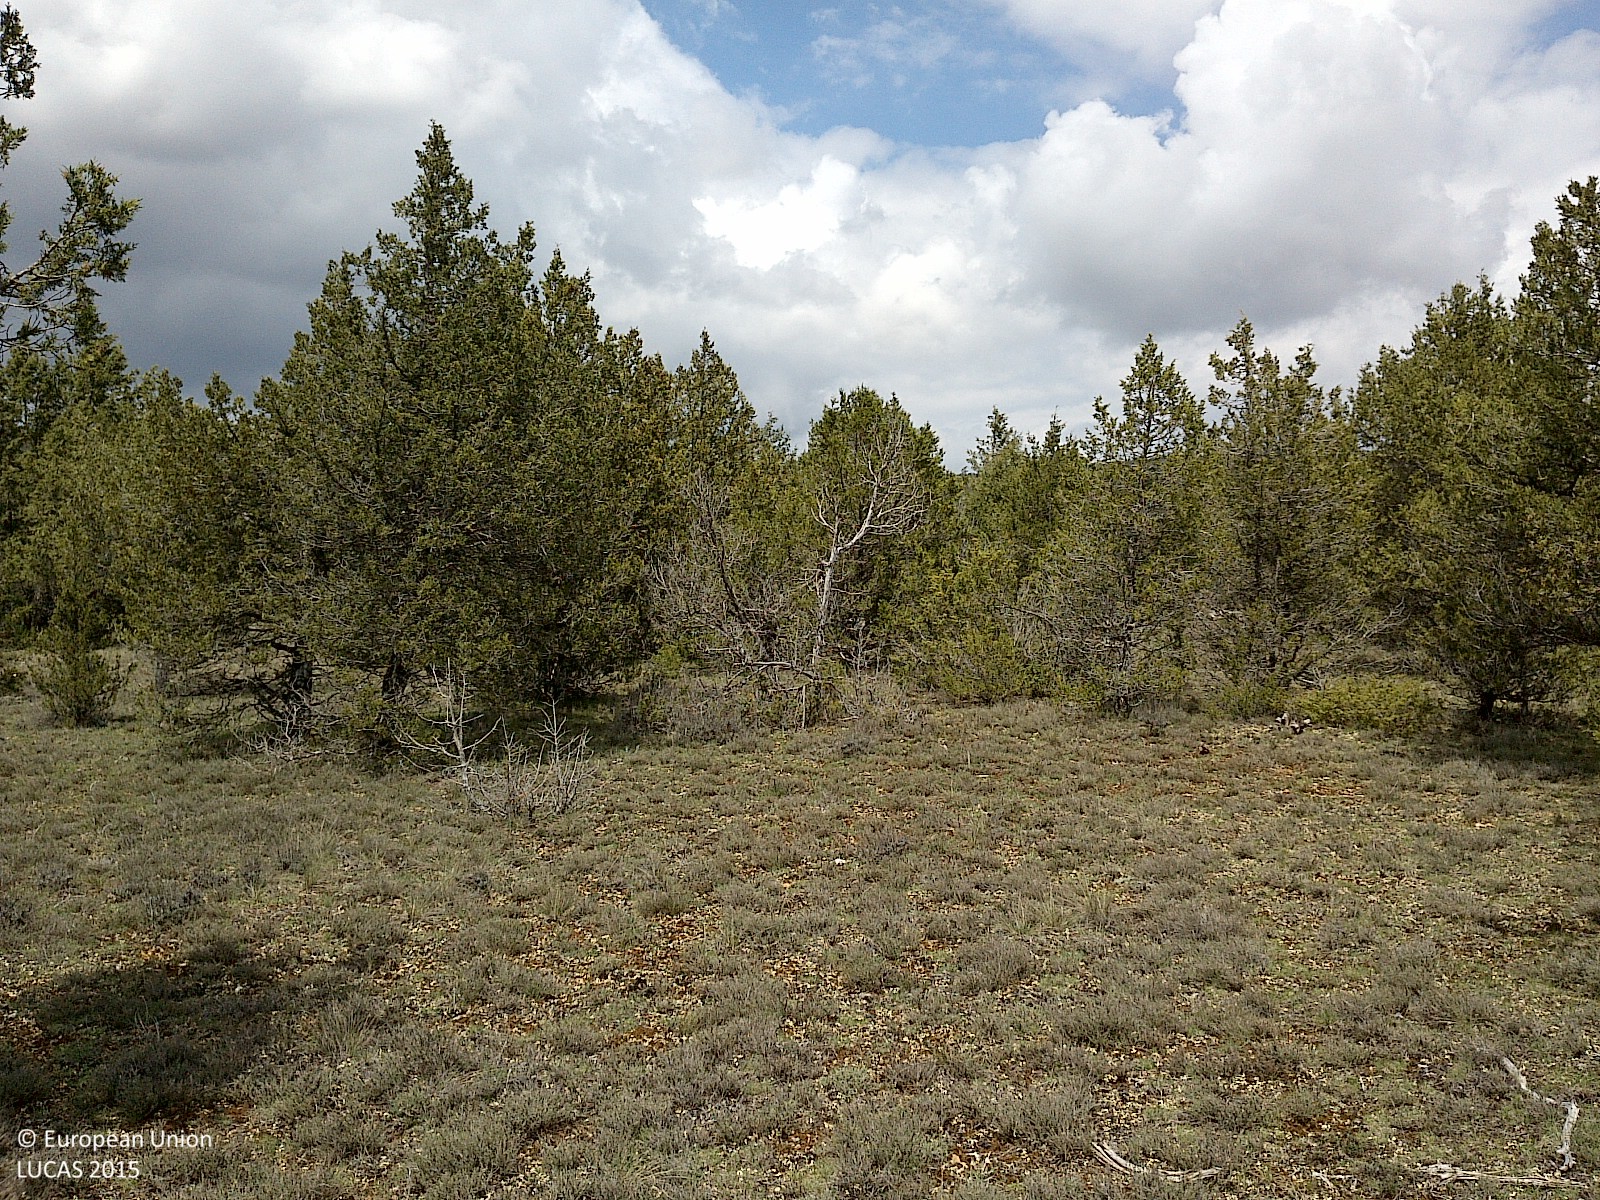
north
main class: Woodland
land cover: Other coniferous woodland
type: coniferous forest of the mediterranean region
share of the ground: 25 - 50 %
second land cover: Grassland without tree/shrub cover
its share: > 75 %
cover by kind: herbaceous plants 65 %, coniferous forest trees 35 %
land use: Forestry
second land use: Agriculture (excluding fallow land and kitchen gardens)
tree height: < 5 m
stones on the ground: 10 - 25 %
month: April
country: ES
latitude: 41.7646
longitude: -2.8043
